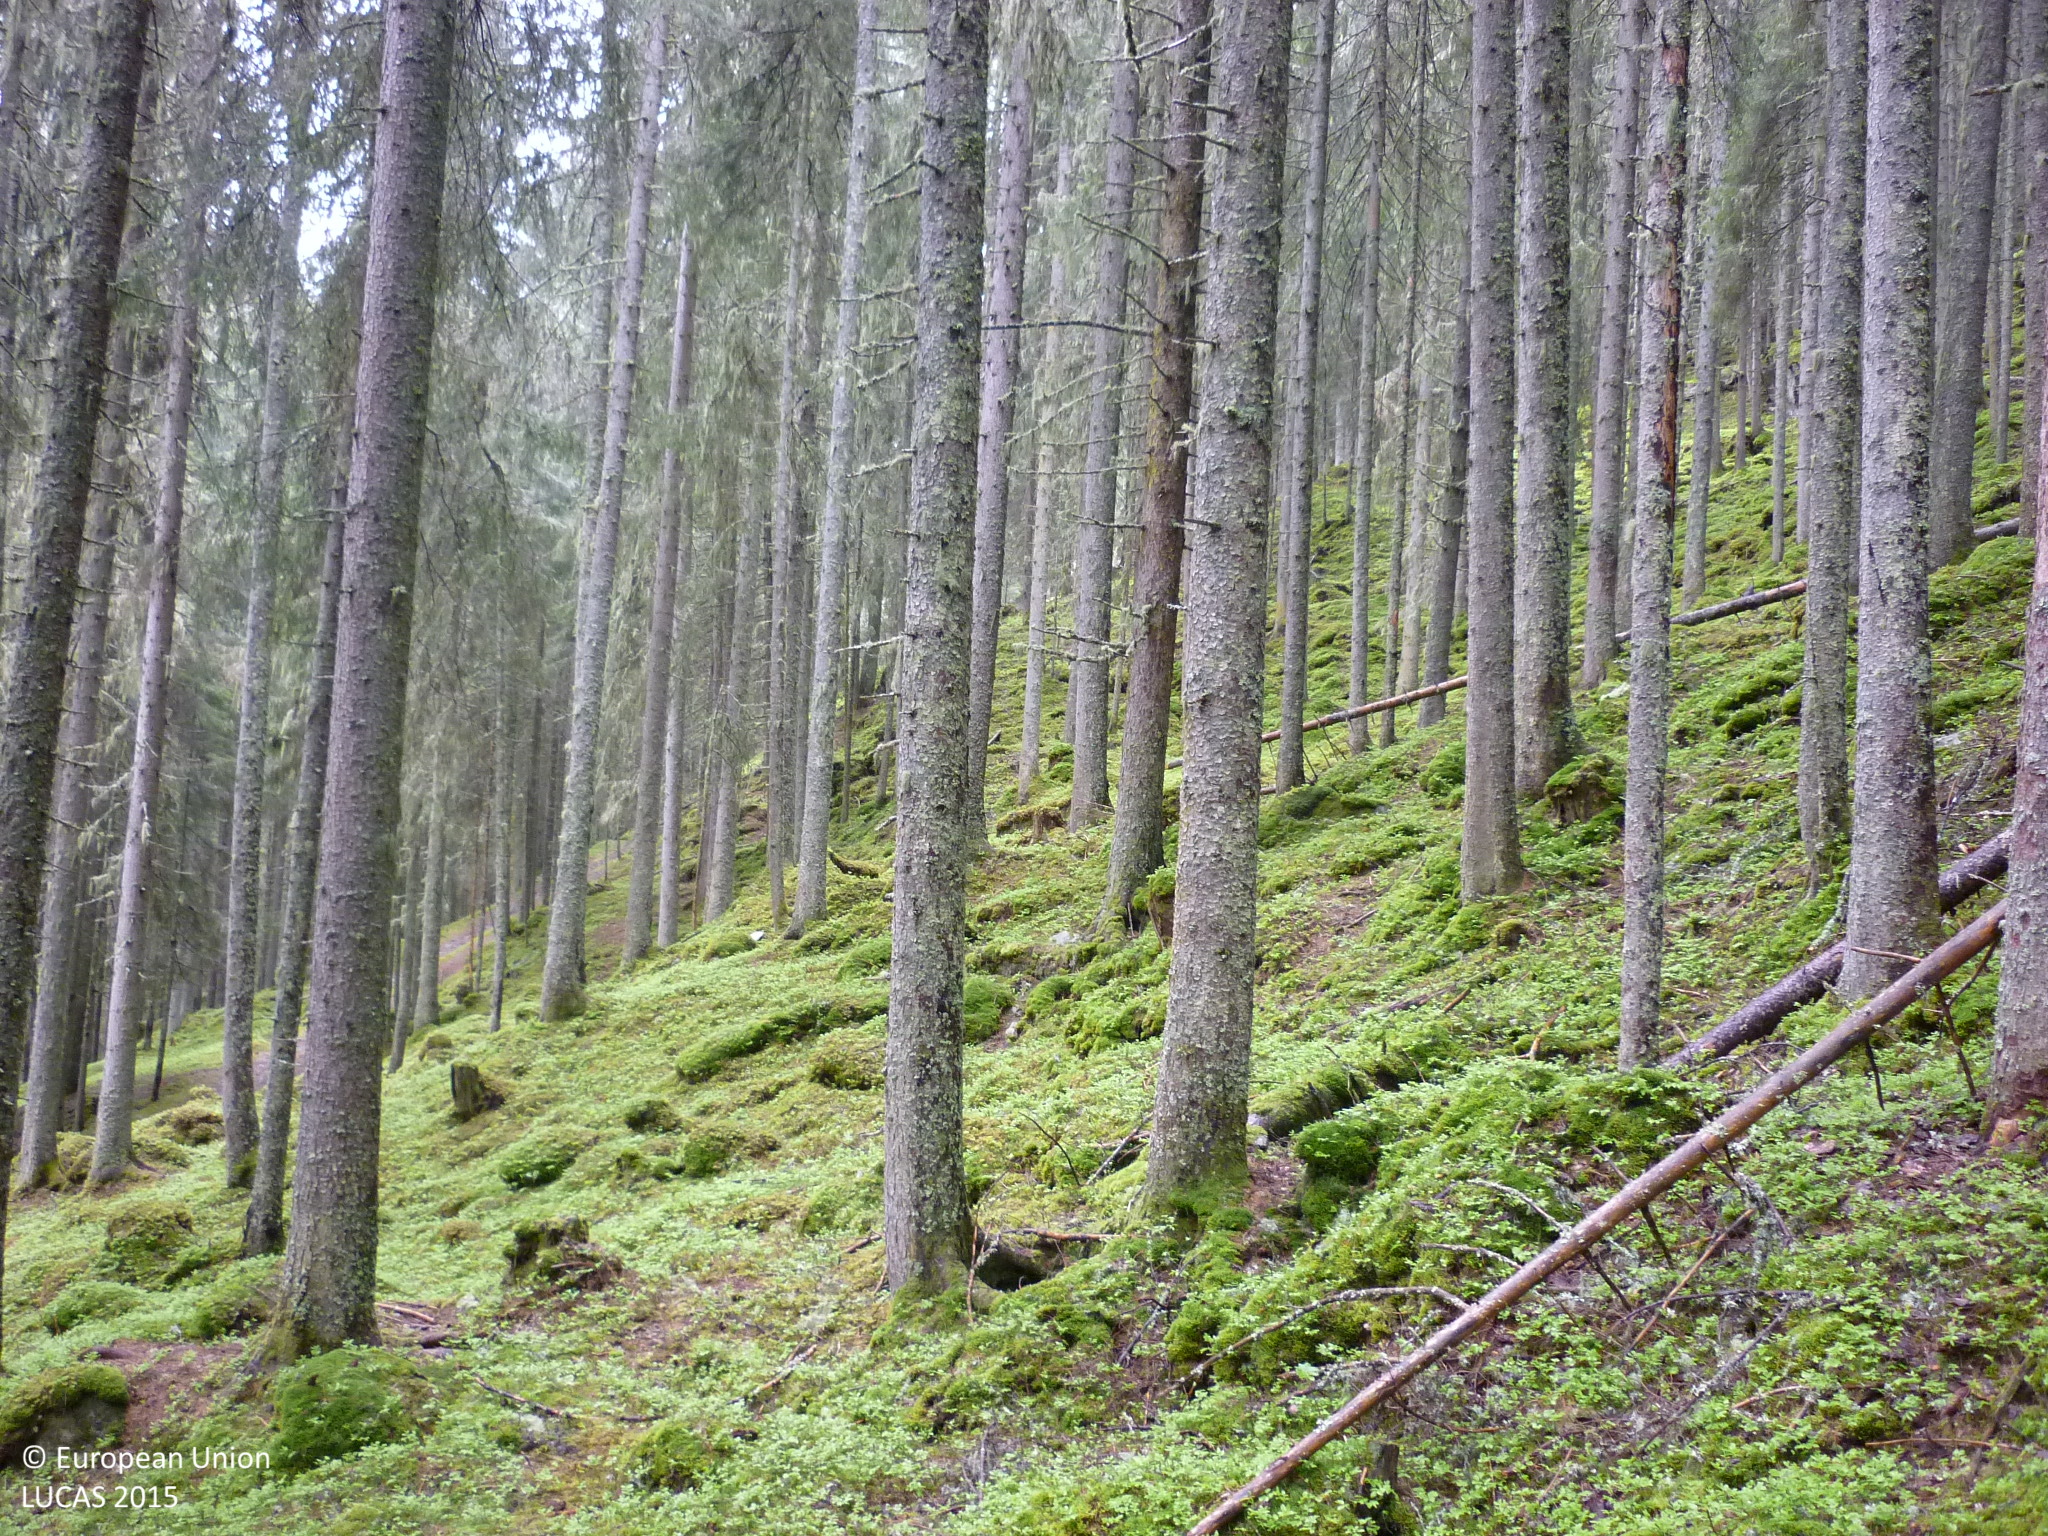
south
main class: Woodland
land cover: Spruce dominated coniferous woodland
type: alpine coniferous forest
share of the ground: > 75 %
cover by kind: coniferous forest trees 90 %, herbaceous plants 5 %, lichens and mosses 5 %
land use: Forestry
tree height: > 5 m
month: May
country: AT
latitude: 47.4077
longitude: 14.1200
